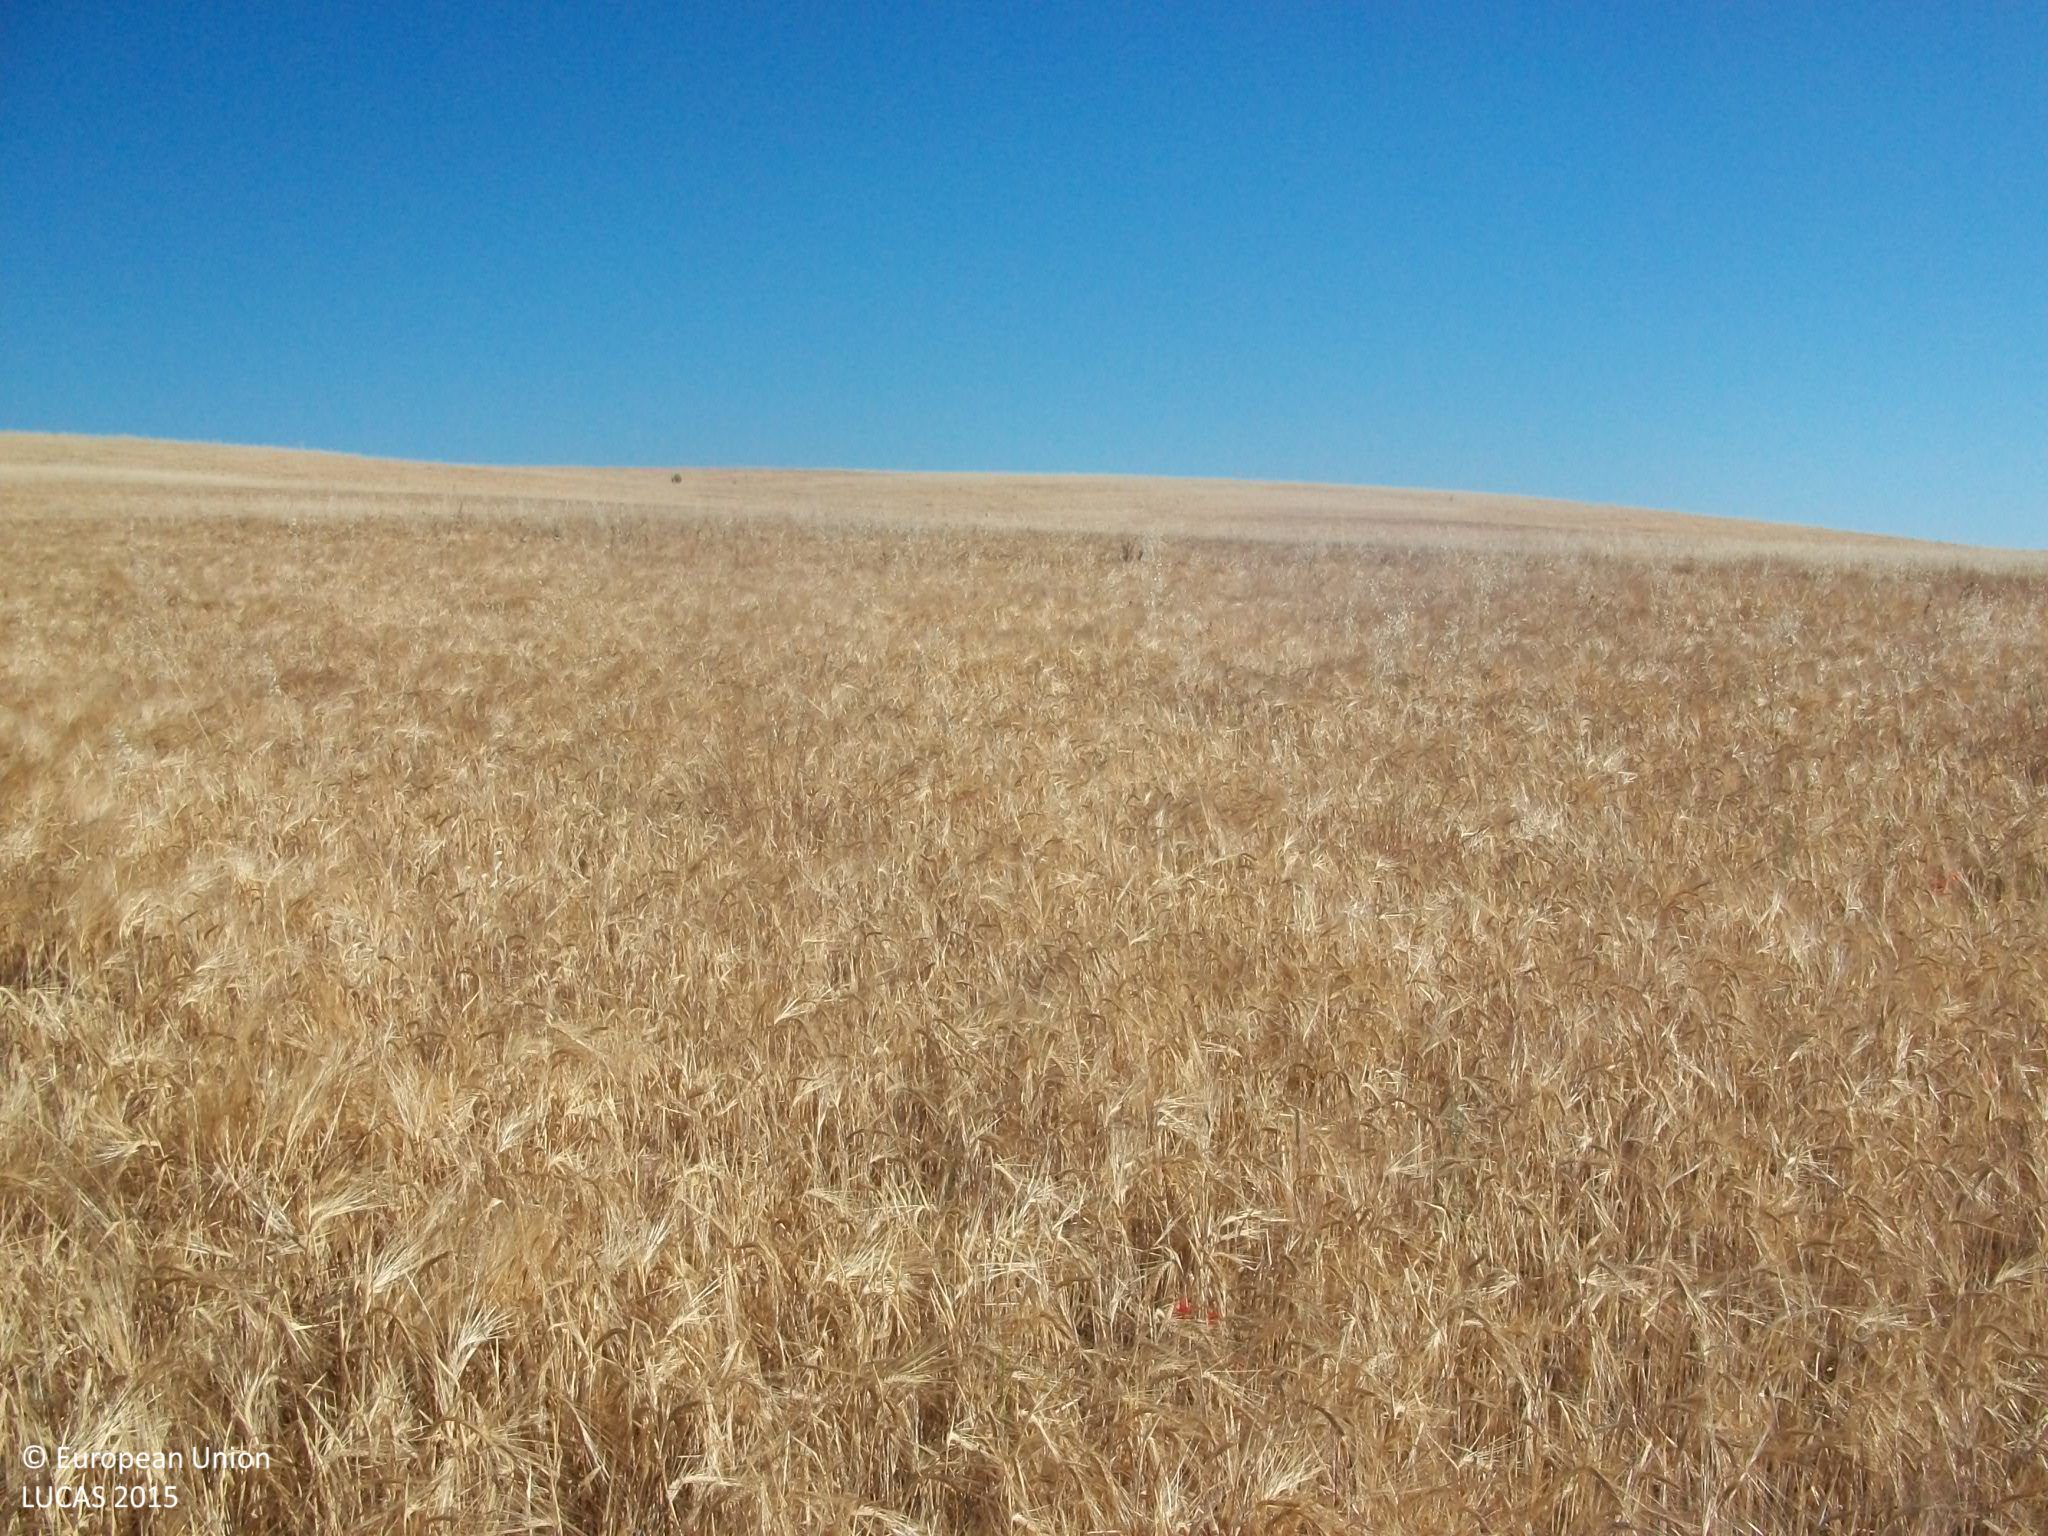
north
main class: Cropland
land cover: Barley
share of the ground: > 75 %
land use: Agriculture (excluding fallow land and kitchen gardens)
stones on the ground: > 50 %
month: May
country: ES
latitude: 39.9618
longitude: -3.6932
